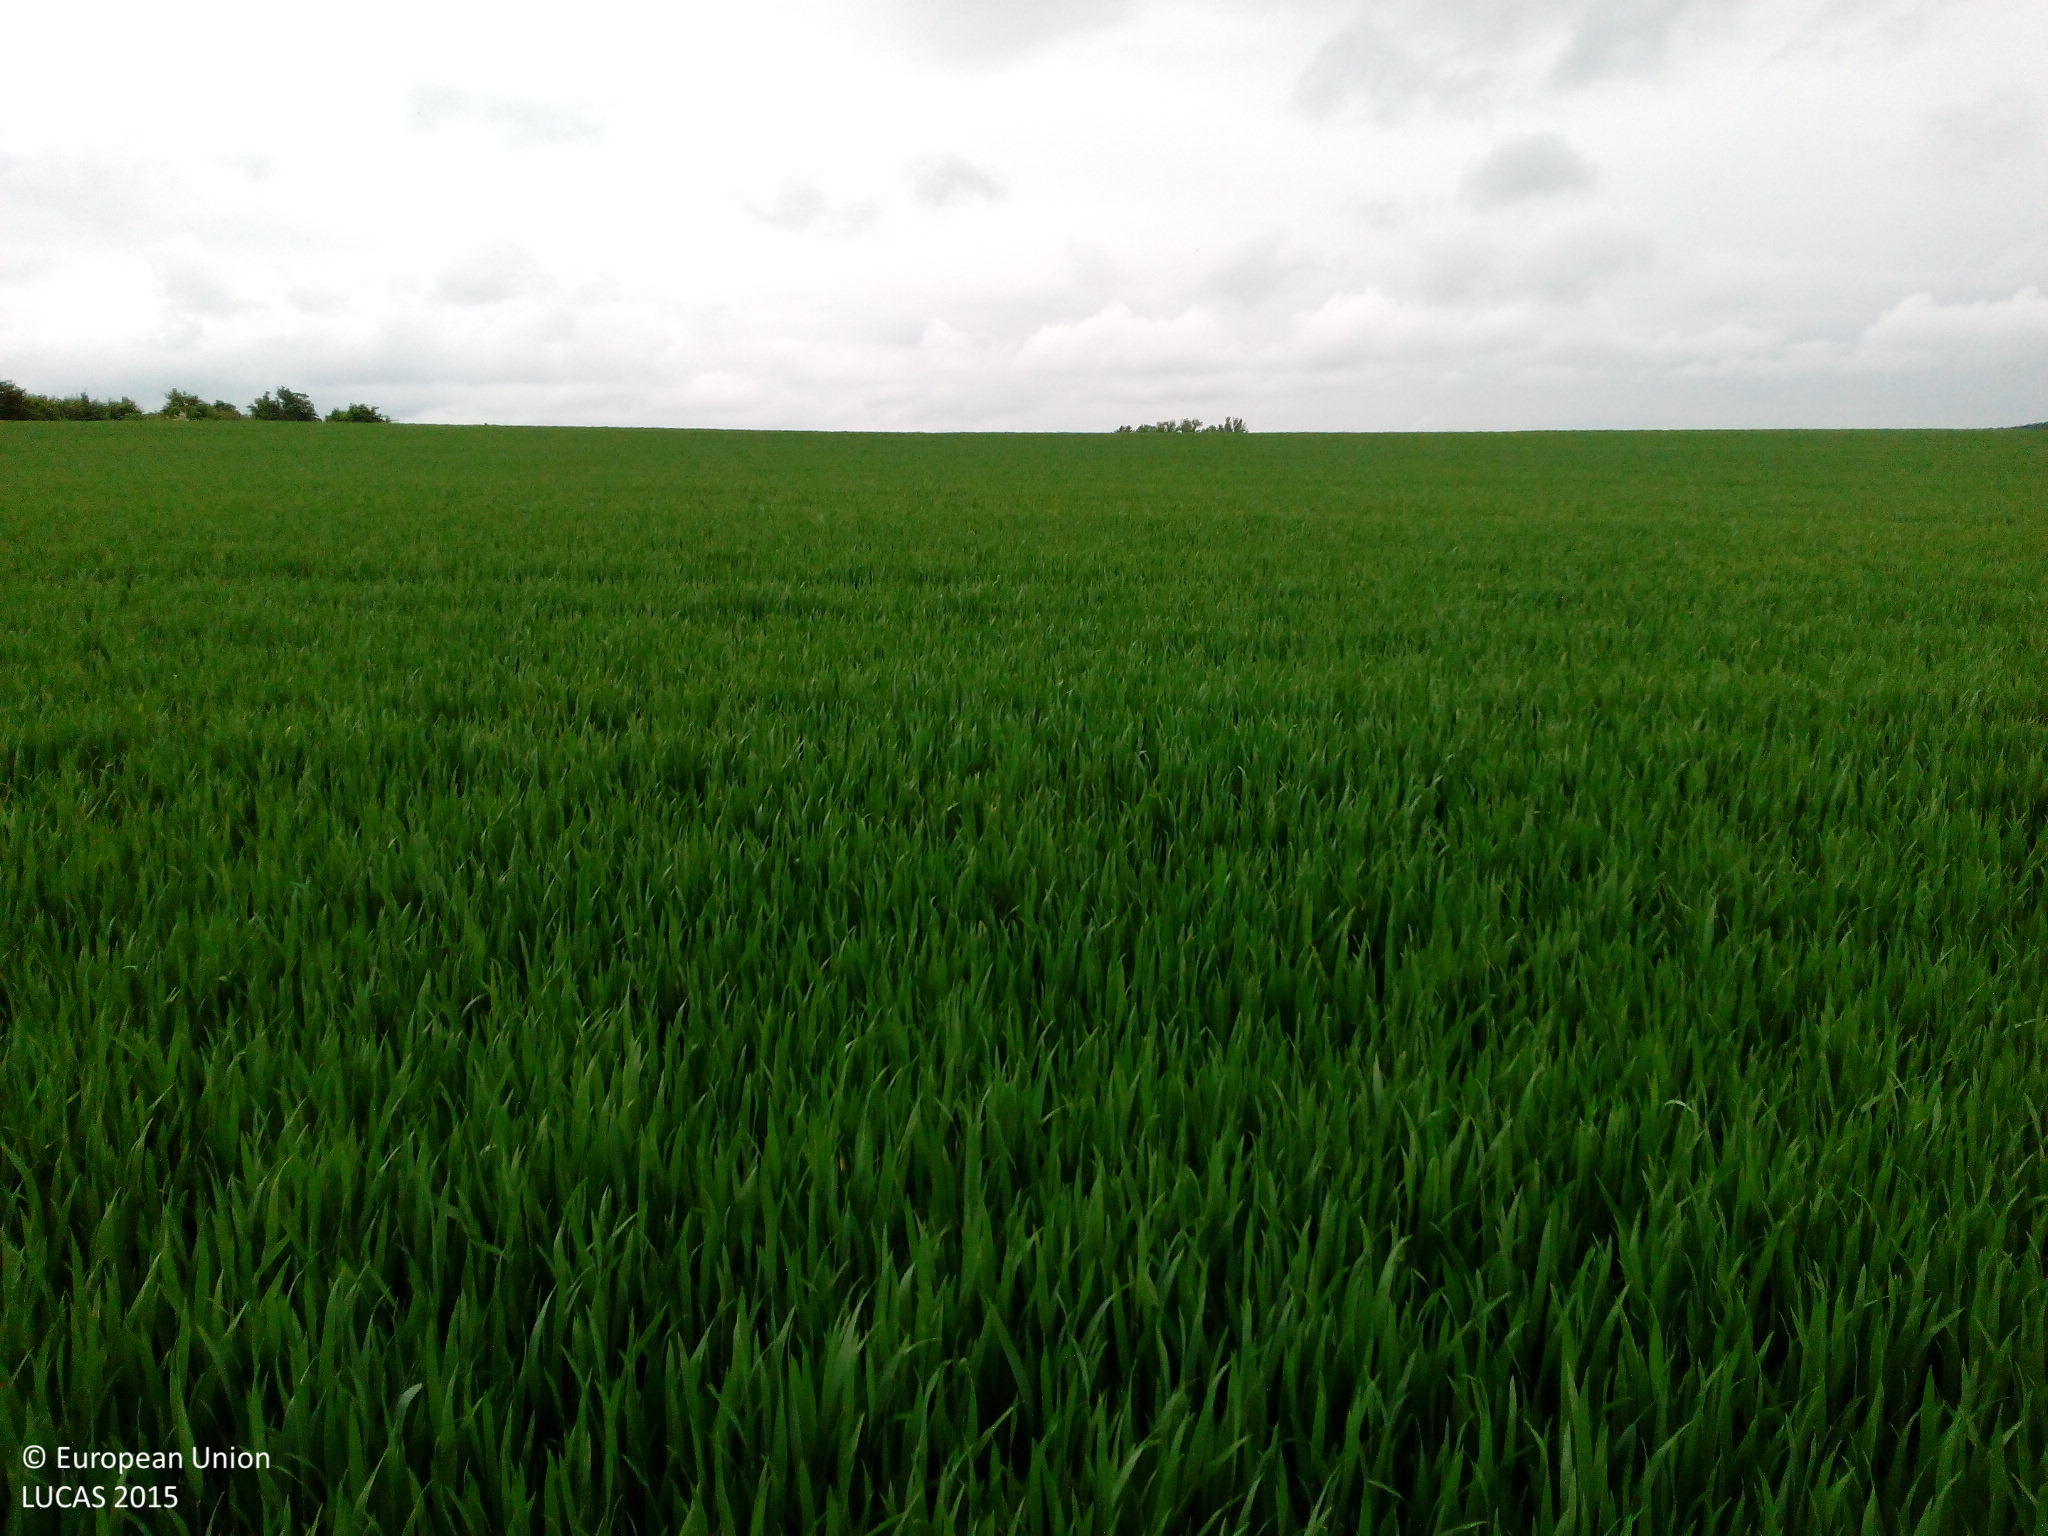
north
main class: Cropland
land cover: Common wheat
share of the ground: > 75 %
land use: Agriculture (excluding fallow land and kitchen gardens)
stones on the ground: < 10 %
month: May
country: DE
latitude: 49.1766
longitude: 10.3154
